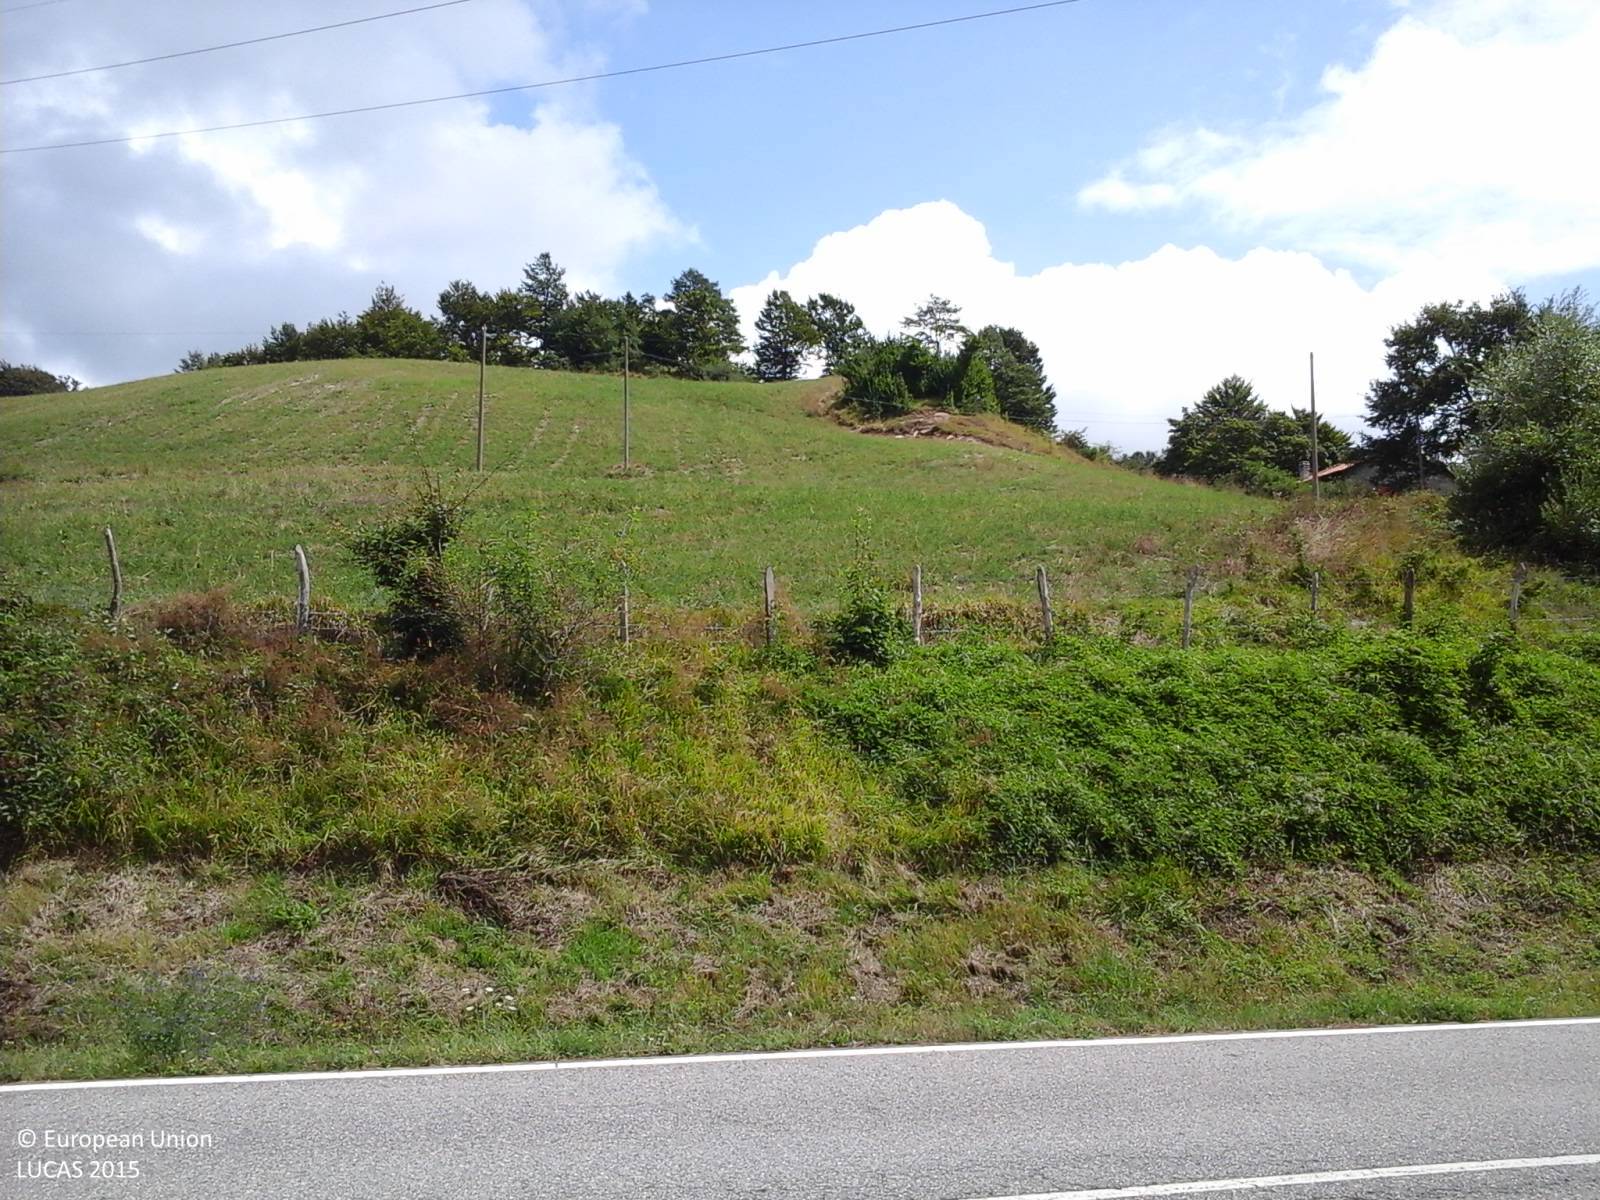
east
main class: Woodland
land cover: Broadleaved woodland
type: thermophilous deciduous forest
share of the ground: > 75 %
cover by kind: broadleaved forest trees 80 %, shrubs 20 %
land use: Forestry
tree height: > 5 m
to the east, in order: Broadleaved woodland; Shrubland with sparse tree cover; Electric lines; Shrubland with sparse tree cover; Fences; Grass margins; Paved roads, cycling and walking lanes; Grass margins; Fences; Grassland without tree/shrub cover; Electric lines; Grassland without tree/shrub cover; Tracks; Grassland without tree/shrub cover; Electric lines; Grassland without tree/shrub cover; Broadleaved woodland; Grassland without tree/shrub cover
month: August
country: IT
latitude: 43.6793
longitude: 12.1157
